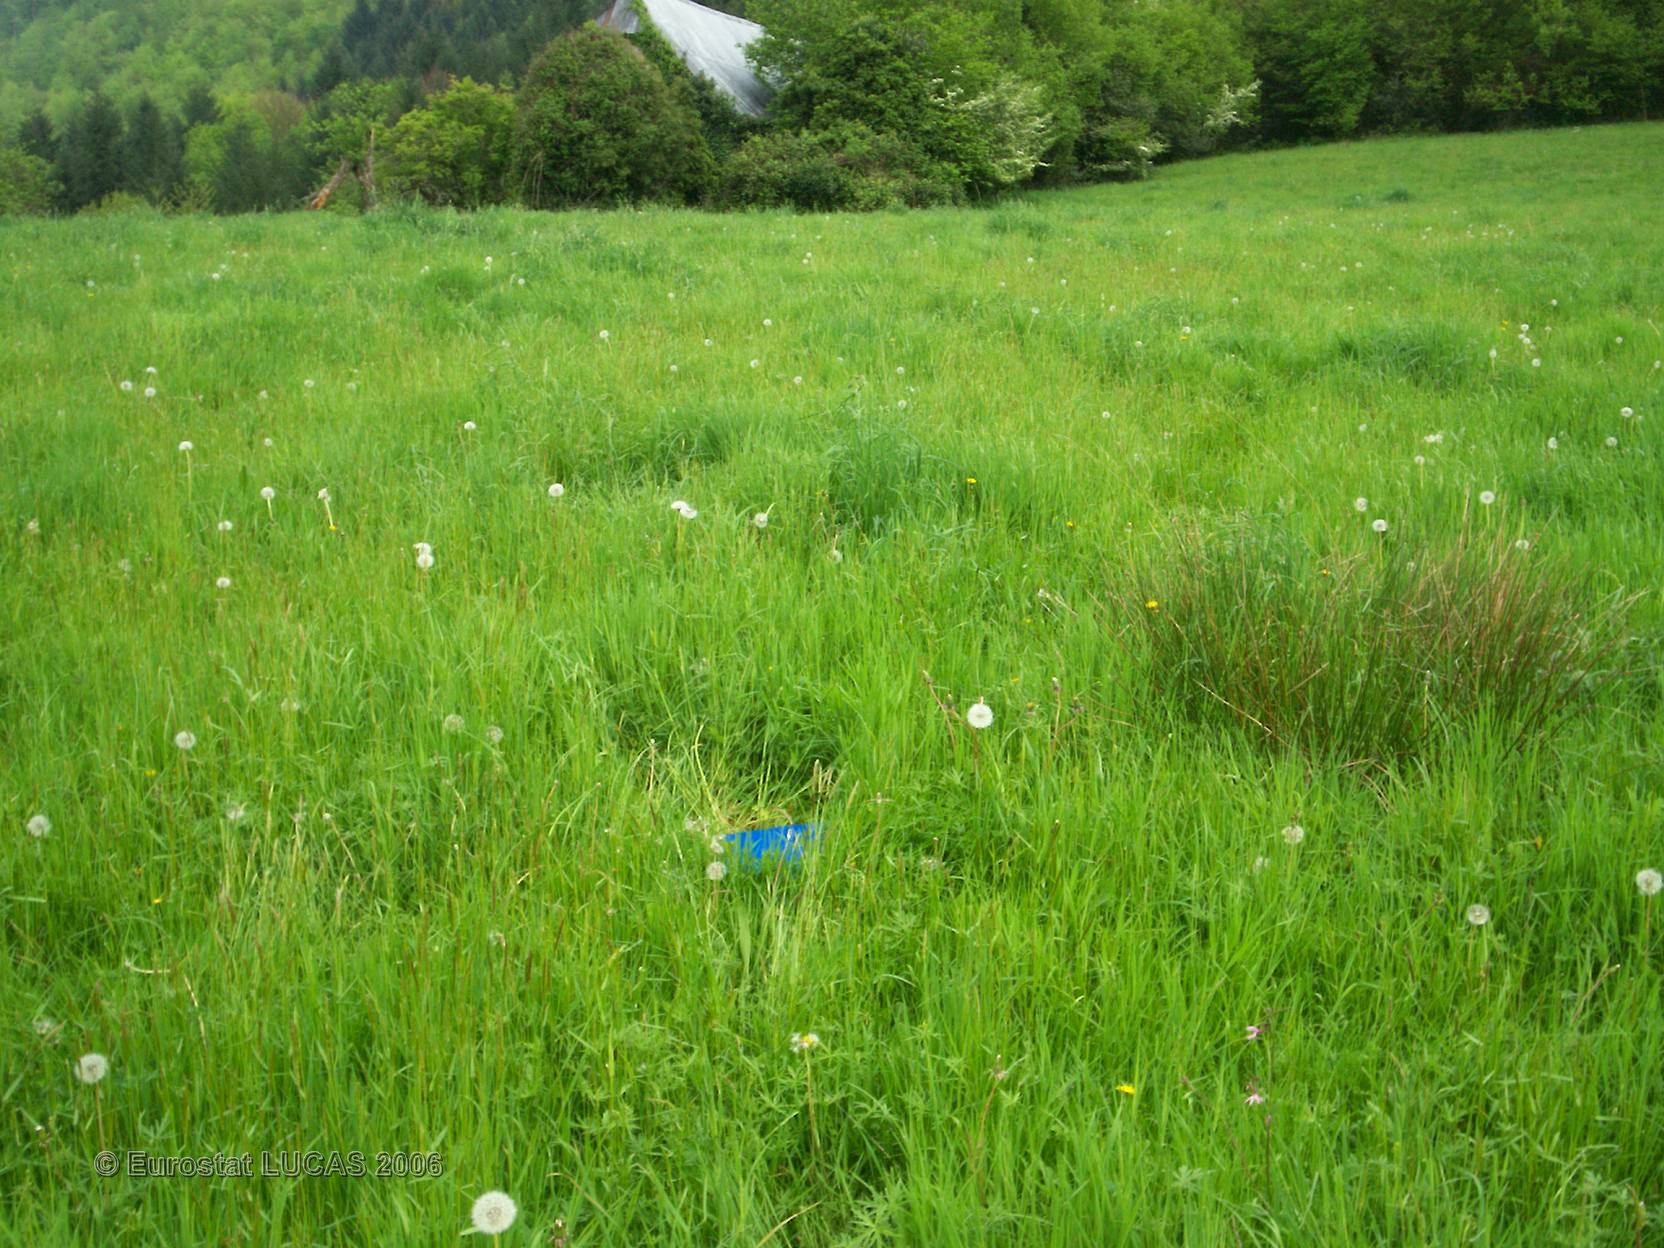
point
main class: Grassland
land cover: Grassland without tree/shrub cover
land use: Agriculture (excluding fallow land and kitchen gardens)
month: April
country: FR
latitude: 43.0920
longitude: -0.1140
